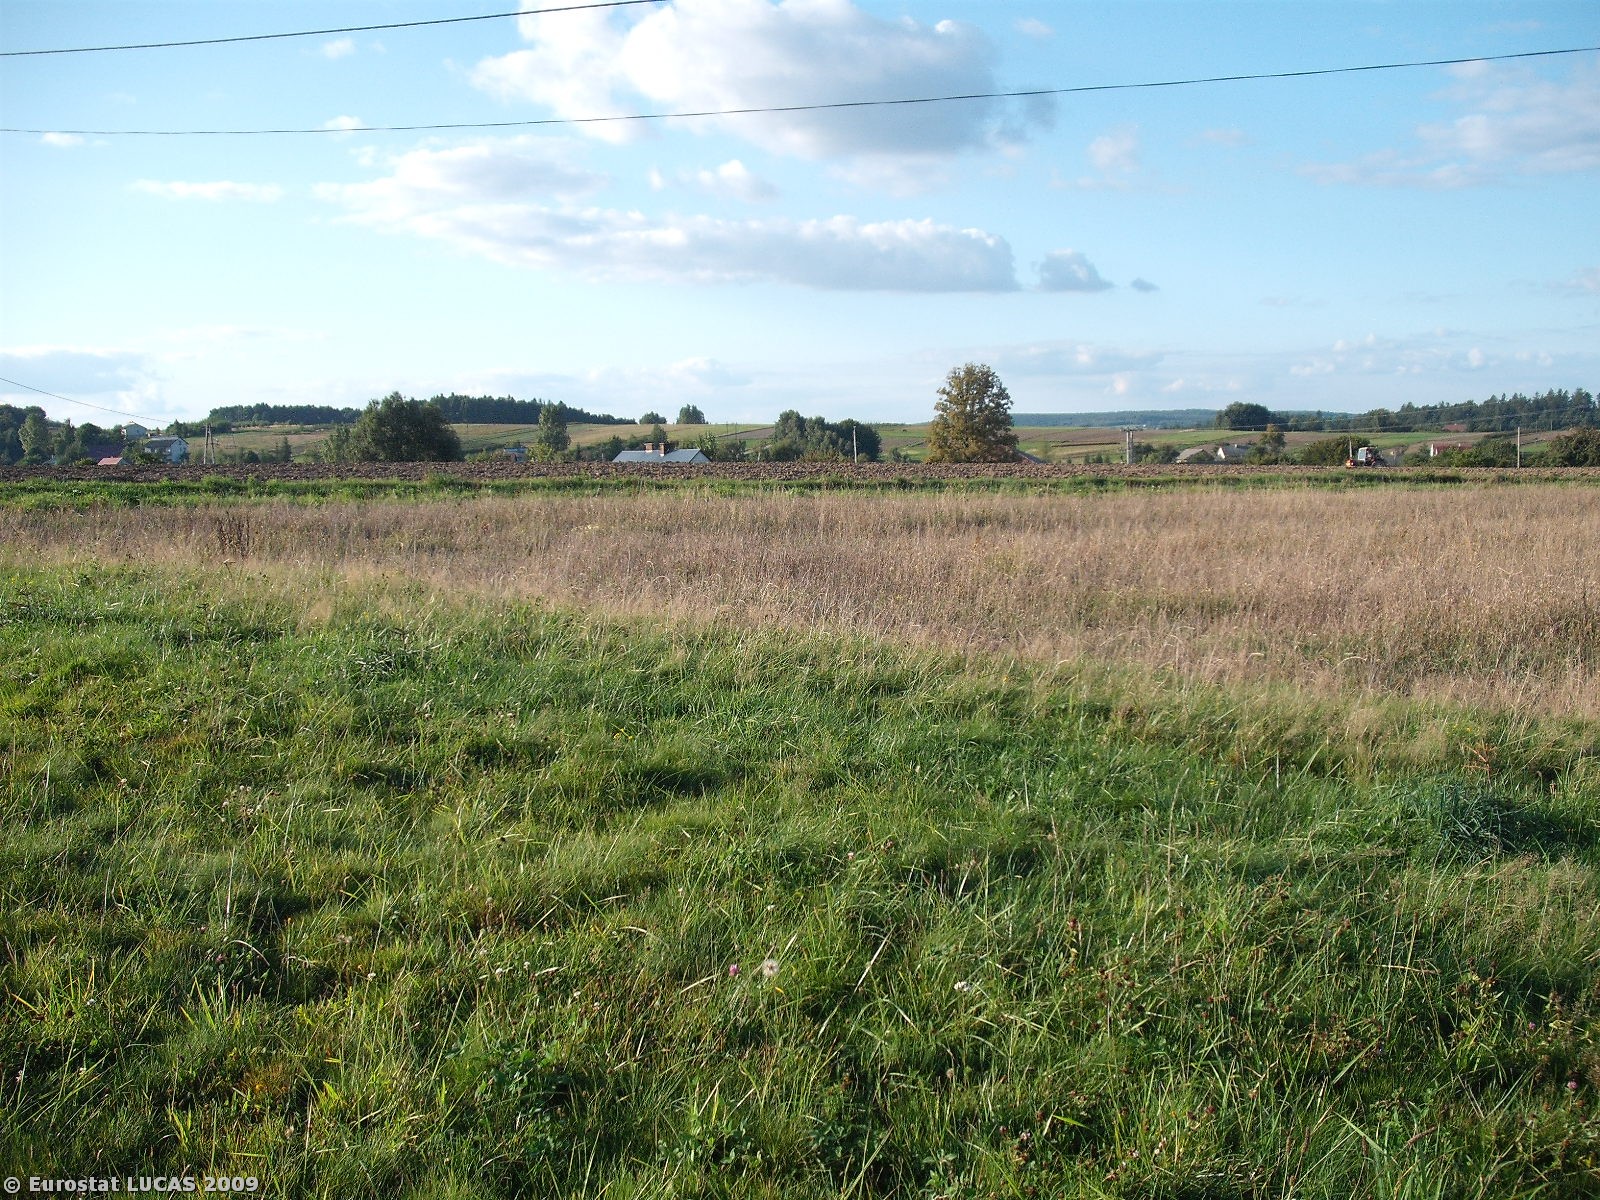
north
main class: Grassland
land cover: Grassland with sparse tree/shrub cover
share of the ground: > 75 %
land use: Agriculture (excluding fallow land and kitchen gardens)
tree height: > 5 m
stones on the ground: < 10 %
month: September
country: PL
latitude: 49.8740
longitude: 22.0100
